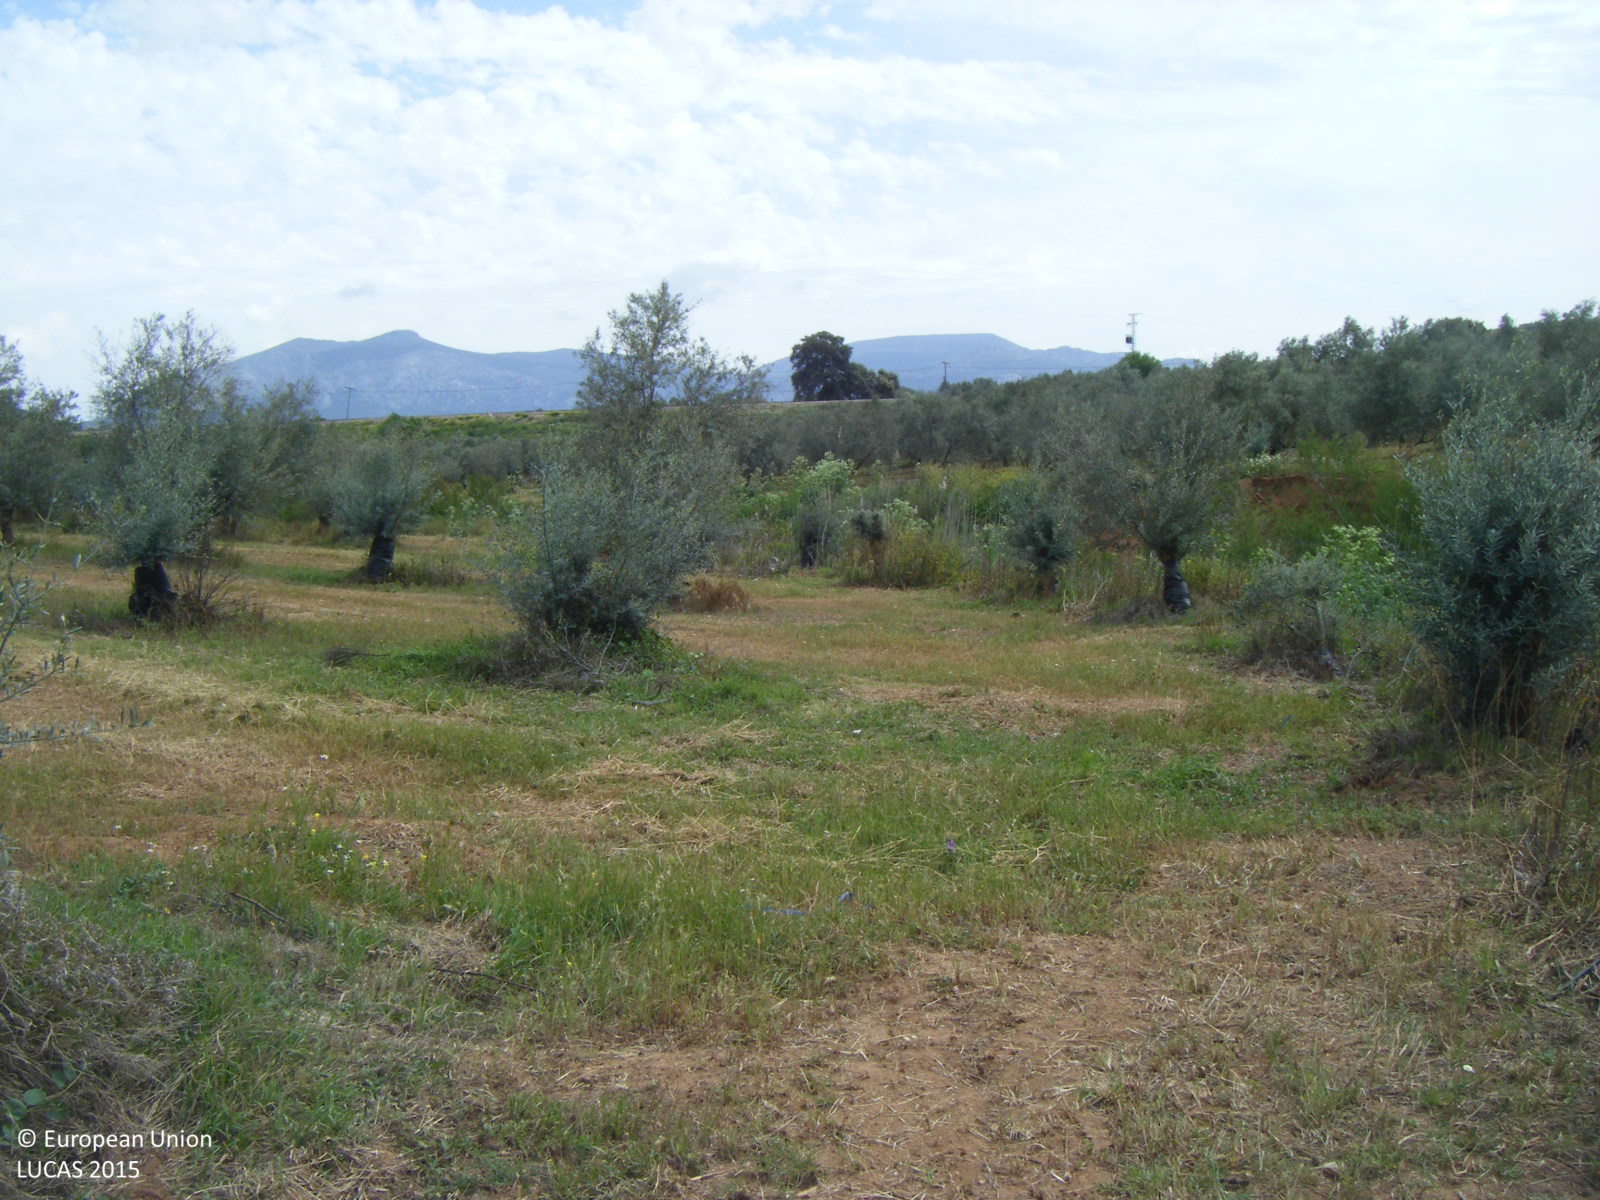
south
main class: Grassland
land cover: Grassland without tree/shrub cover
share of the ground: > 75 %
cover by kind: herbaceous plants 100 %
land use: Semi-natural and natural areas not in use
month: April
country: ES
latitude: 37.0306
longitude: -4.7594
